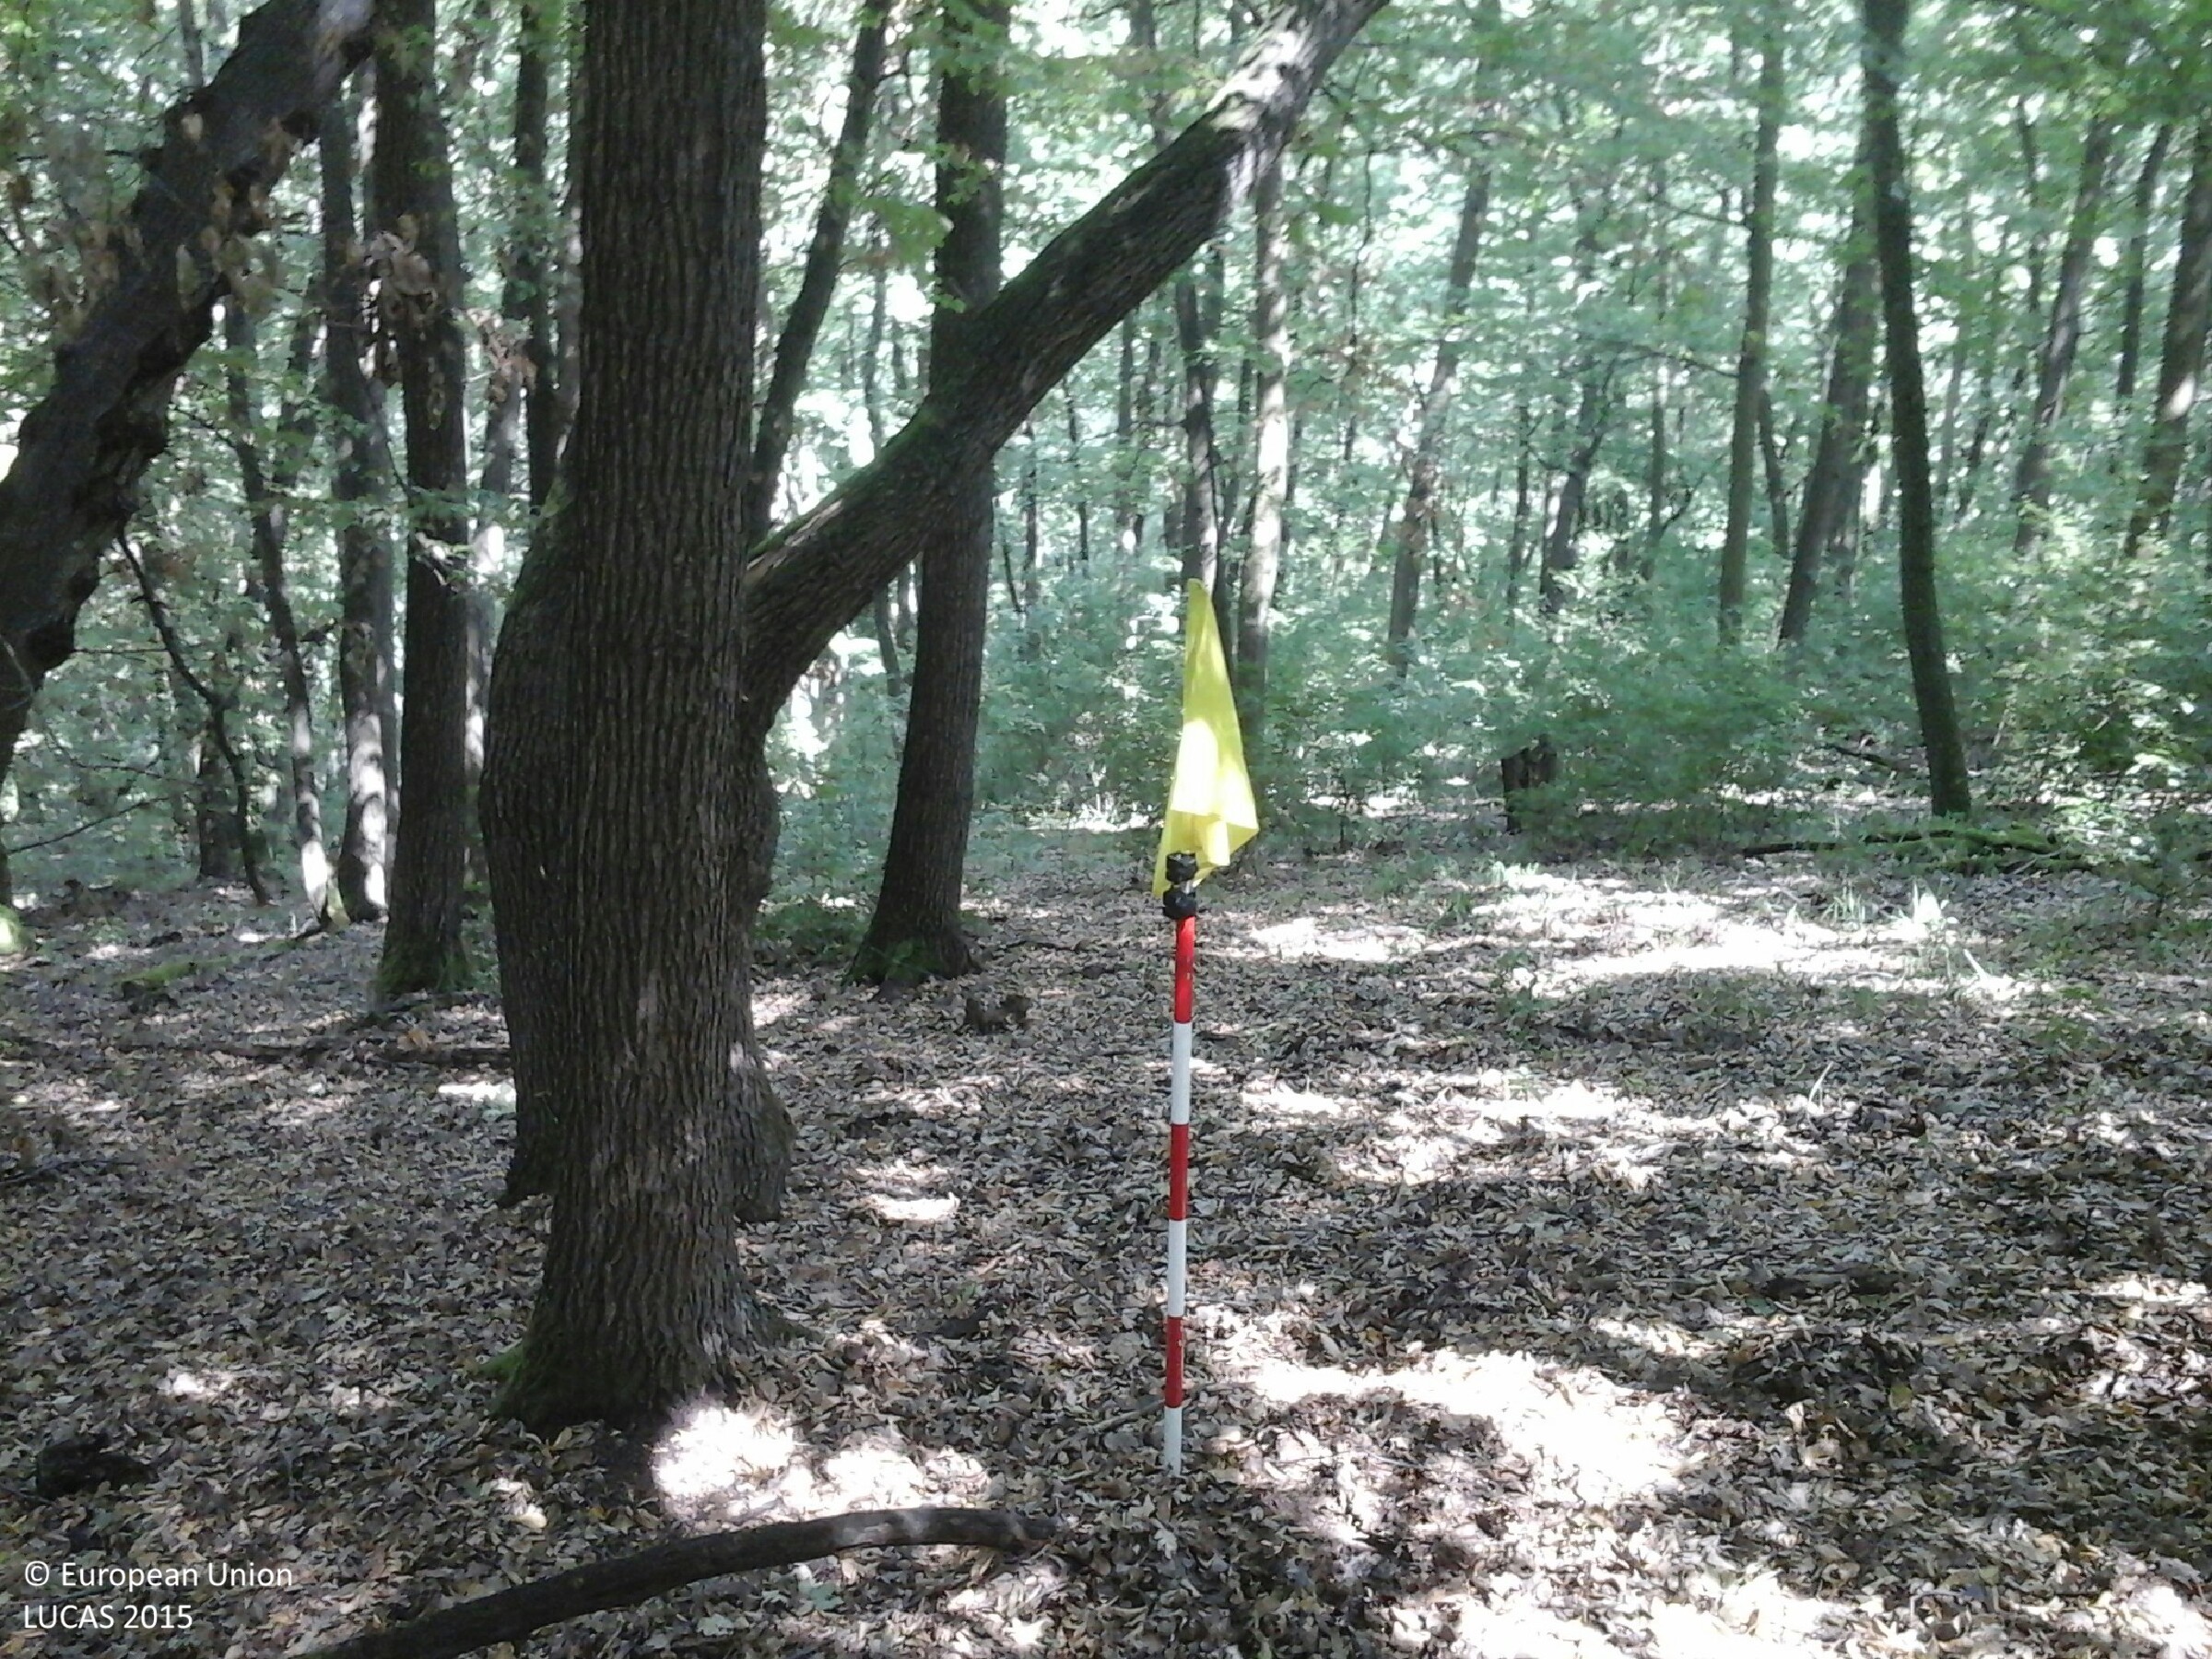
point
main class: Woodland
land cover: Broadleaved woodland
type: acidophilous oak and oak-birch forest
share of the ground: > 75 %
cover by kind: broadleaved forest trees 80 %, unconsolidated bare surface 10 %, shrubs 5 %, herbaceous plants 5 %
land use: Forestry
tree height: > 5 m
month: July
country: HU
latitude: 48.3259
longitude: 20.4325
